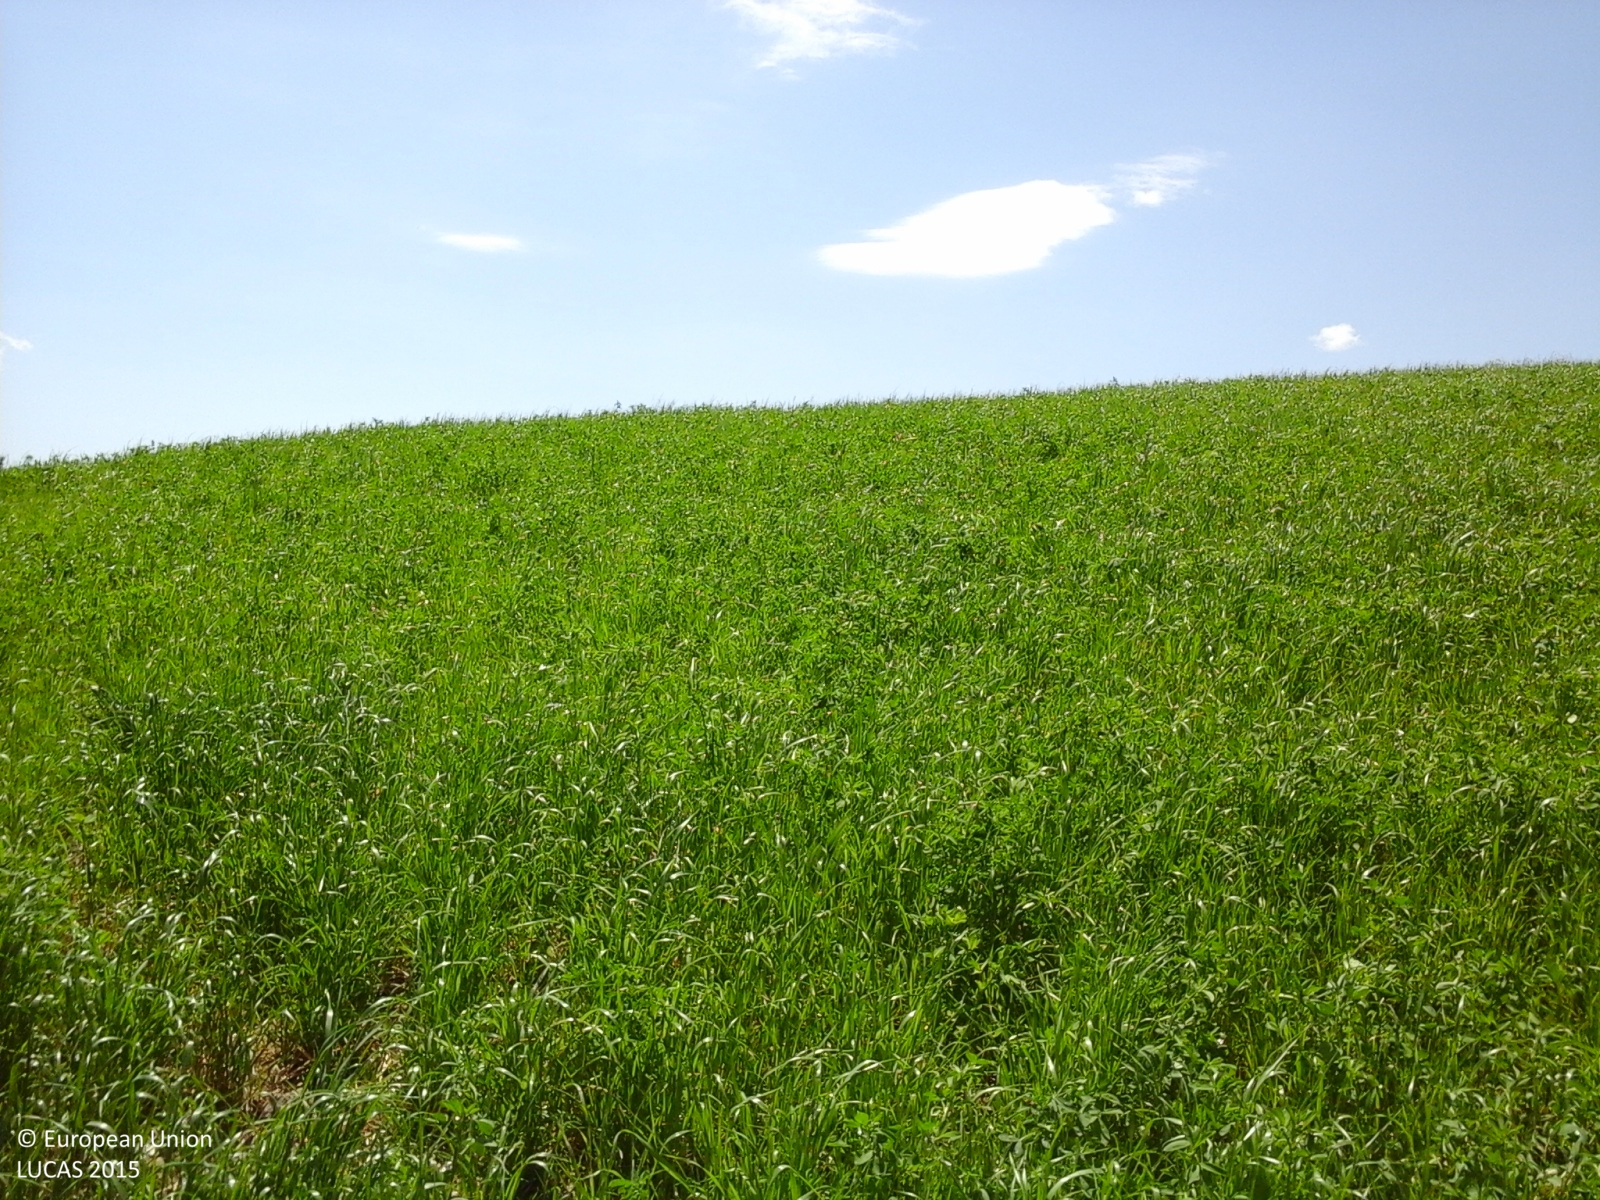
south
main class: Cropland
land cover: Lucerne
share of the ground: > 75 %
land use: Agriculture (excluding fallow land and kitchen gardens)
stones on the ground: < 10 %
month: May
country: IT
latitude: 44.7292
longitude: 10.0630
